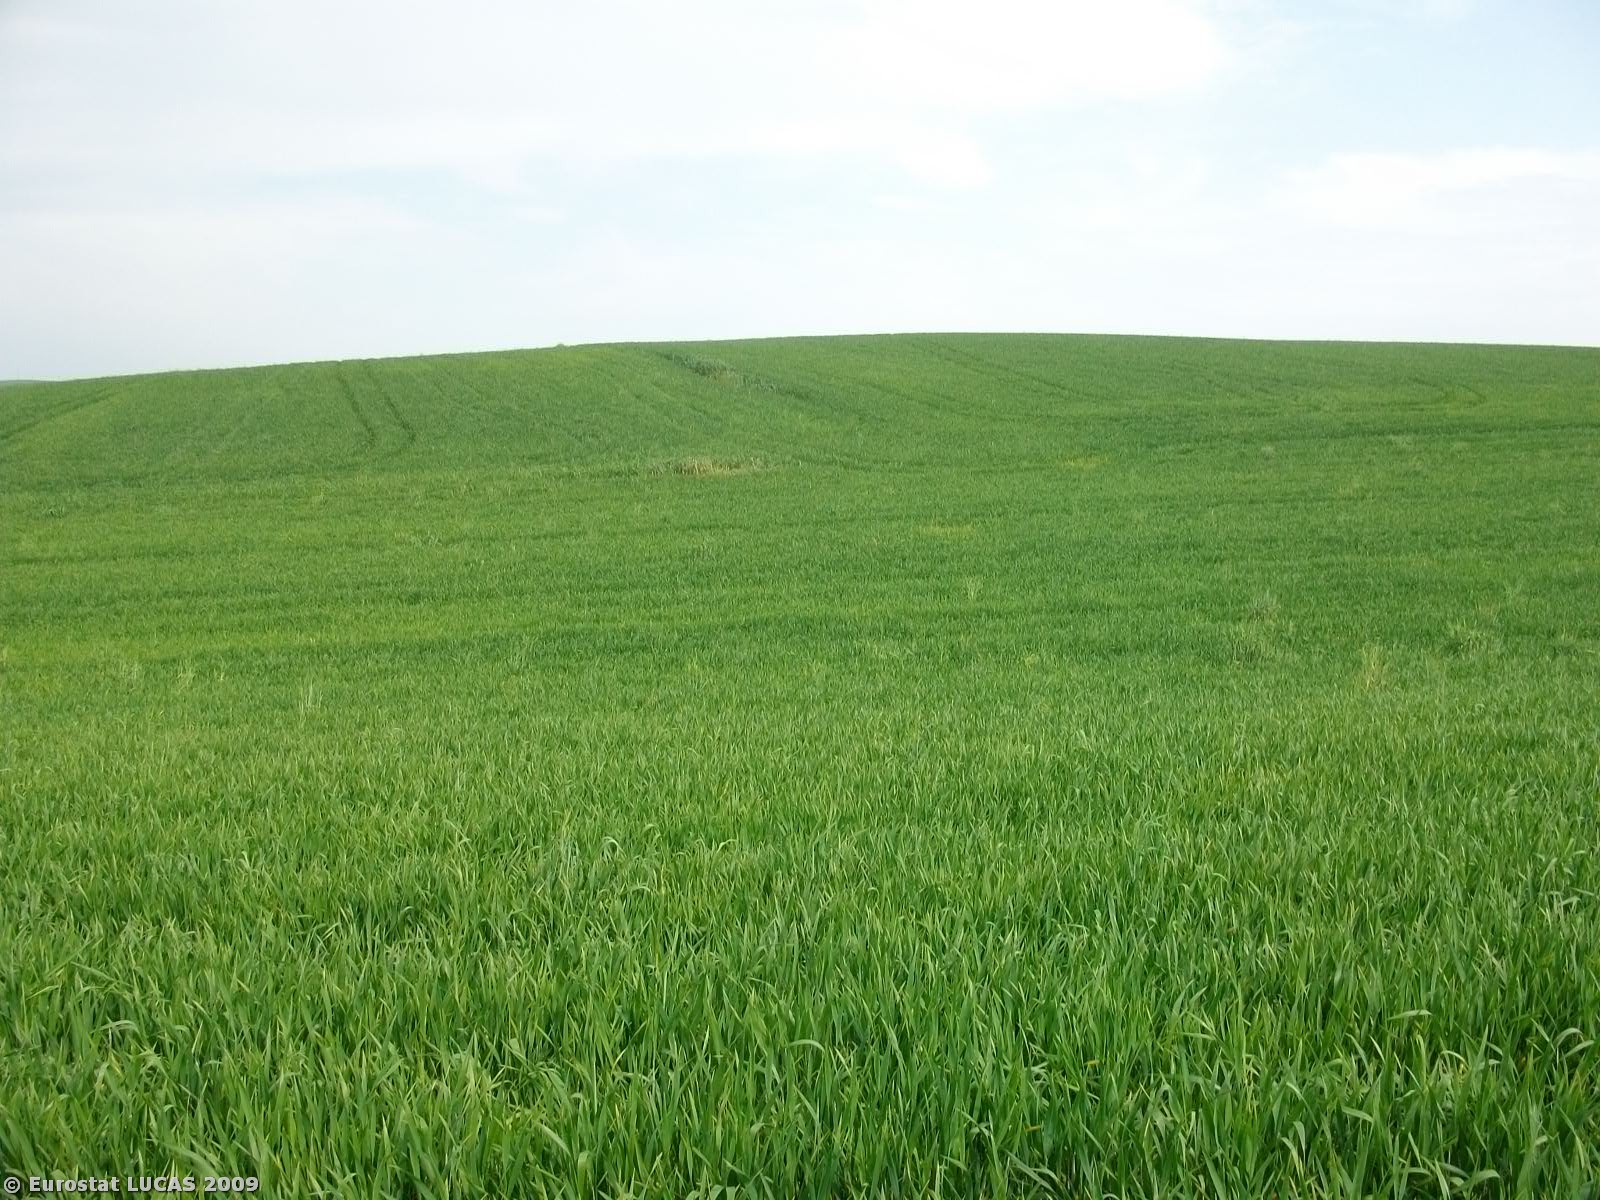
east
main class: Cropland
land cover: Durum wheat
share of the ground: > 75 %
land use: Agriculture (excluding fallow land and kitchen gardens)
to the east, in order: Durum wheat; Tracks; Common wheat
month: April
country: GR
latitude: 39.4845
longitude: 22.4869
